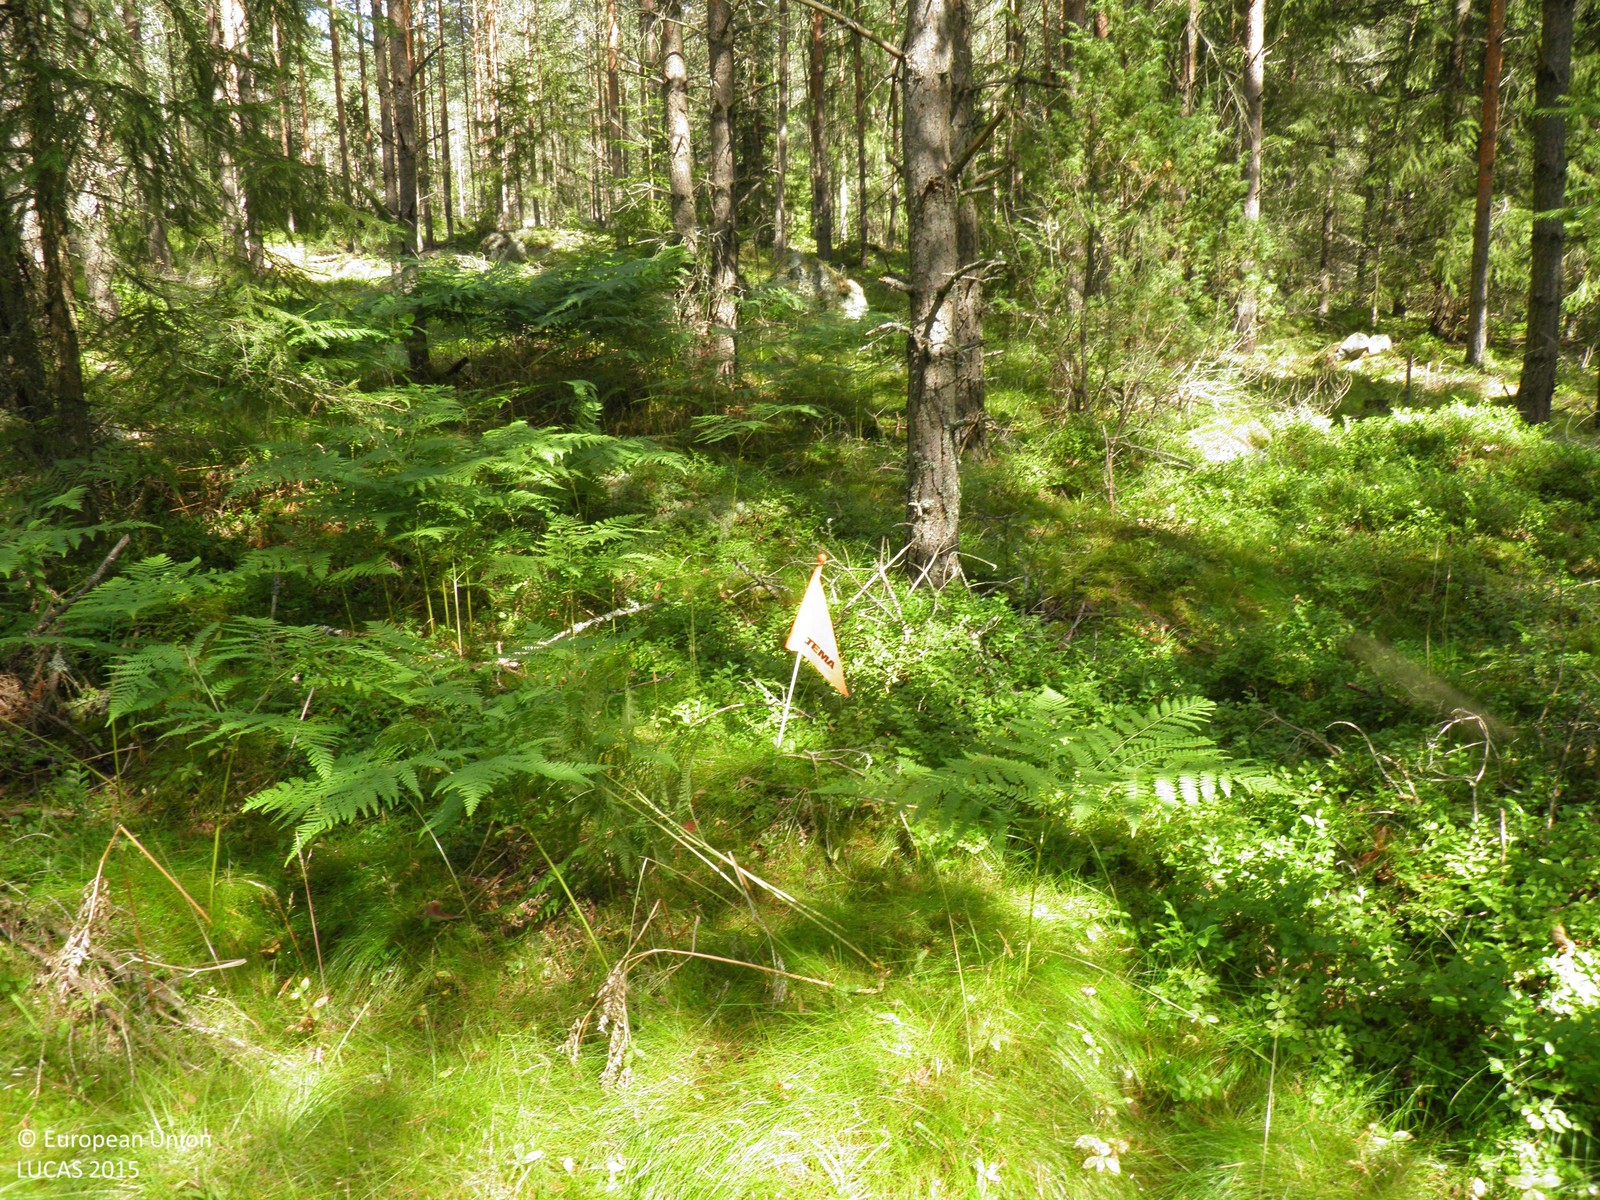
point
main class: Woodland
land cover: Pine dominated coniferous woodland
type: hemiboreal forest and nemoral coniferous forest and mixed broadleaved-coniferous forest
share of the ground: 50 - 75 %
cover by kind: coniferous forest trees 60 %, shrubs 15 %, herbaceous plants 10 %, lichens and mosses 10 %, broadleaved forest trees 5 %
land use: Forestry
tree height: > 5 m
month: August
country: FI
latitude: 60.9800
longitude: 22.8414
